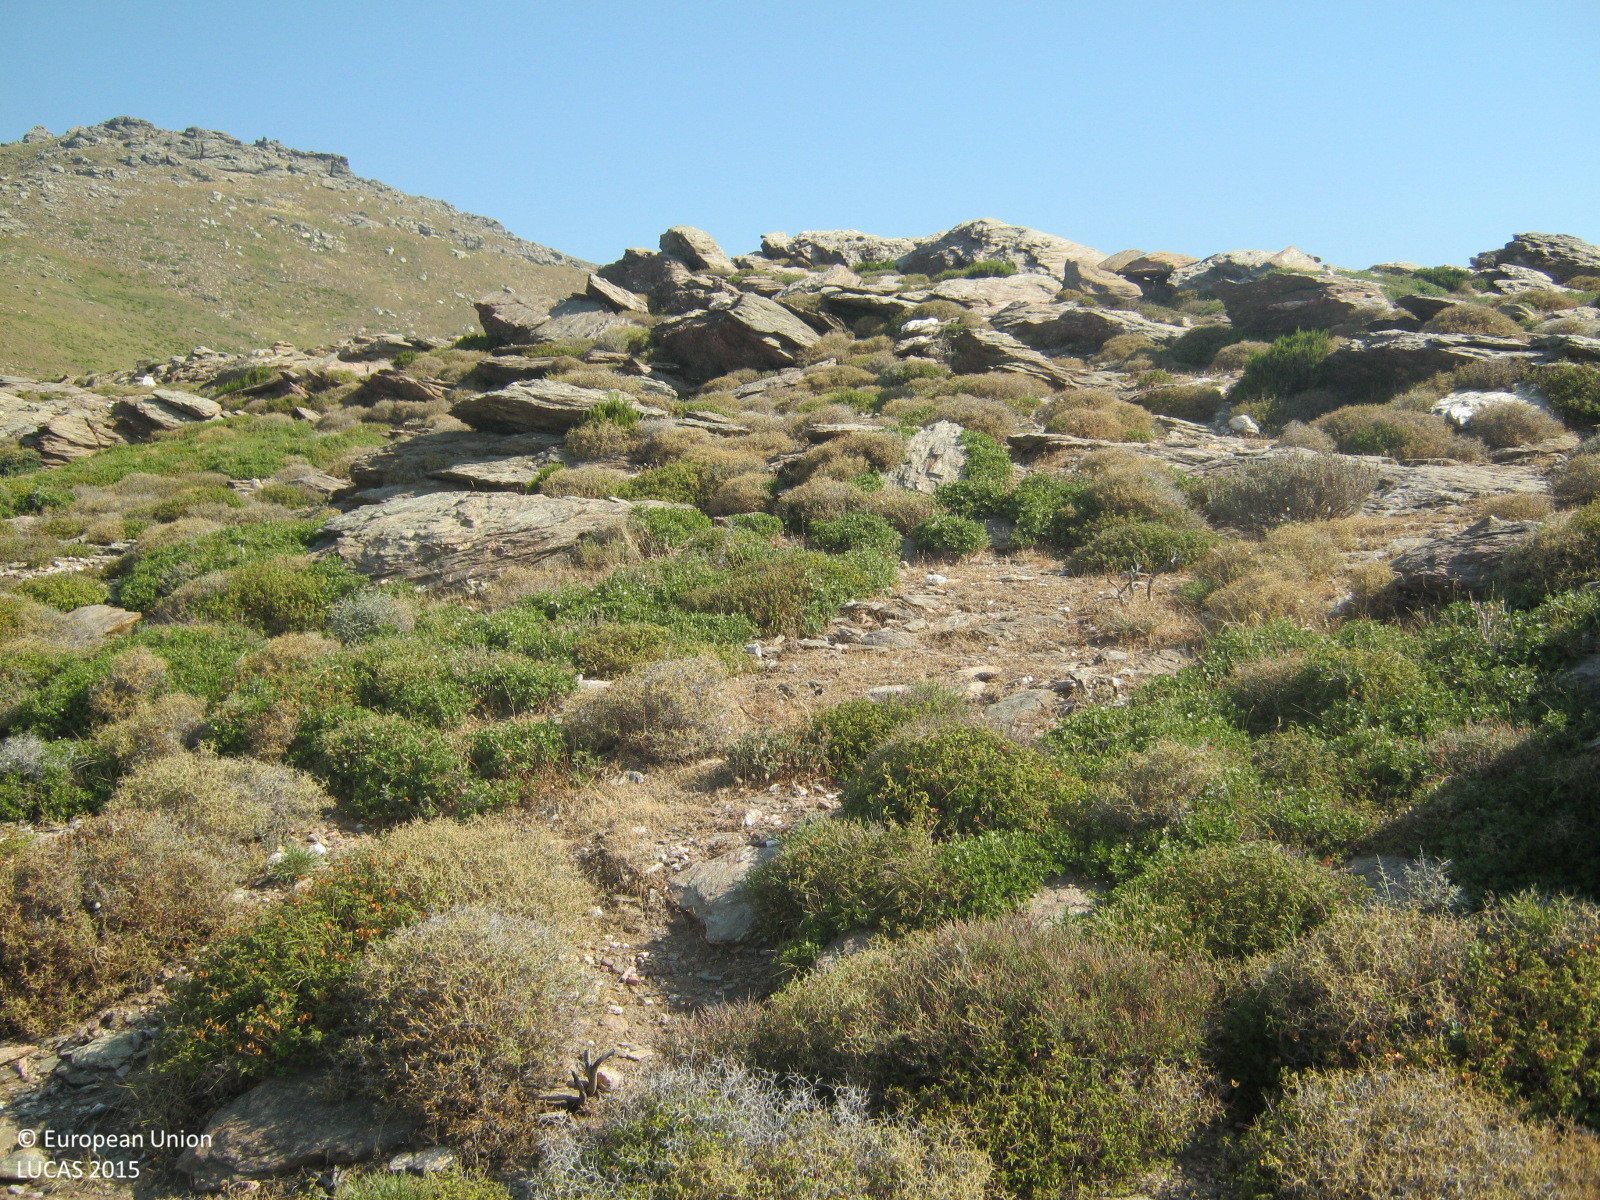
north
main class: Shrubland
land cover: Shrubland without tree cover
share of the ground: 50 - 75 %
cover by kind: shrubs 65 %, herbaceous plants 25 %, unconsolidated bare surface 10 %
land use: Agriculture (excluding fallow land and kitchen gardens)
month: July
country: GR
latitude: 38.0103
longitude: 24.4887
